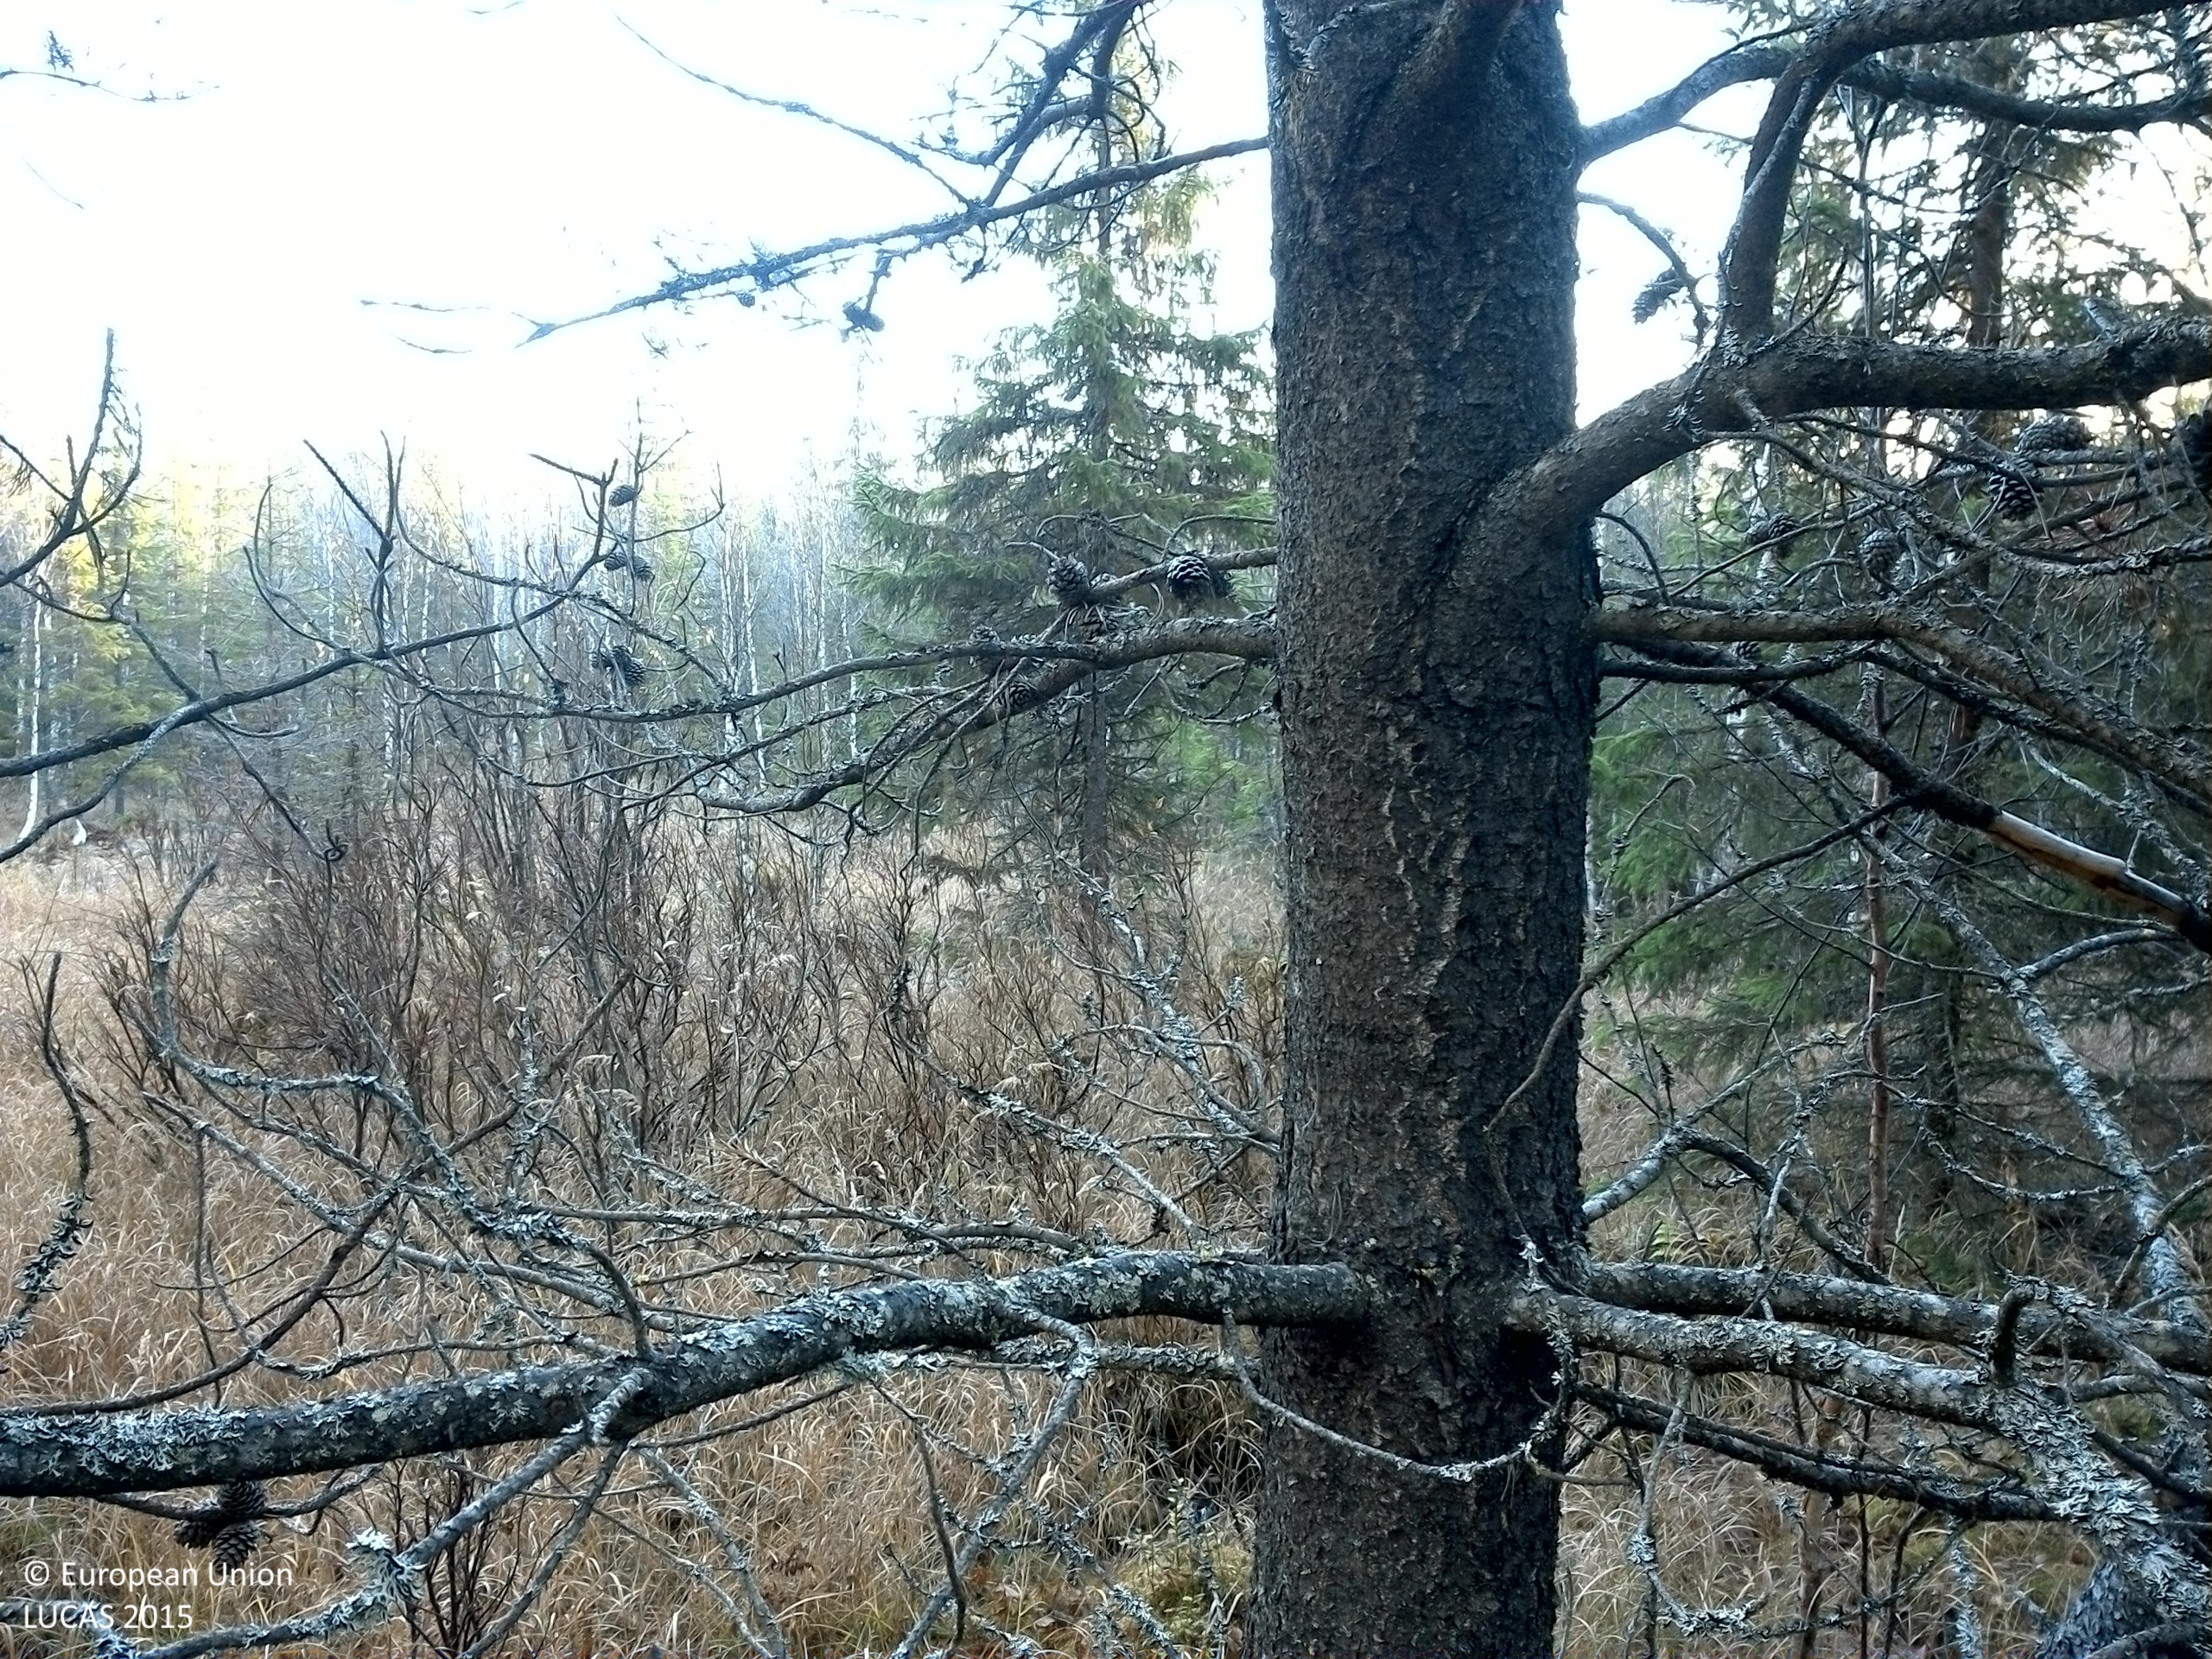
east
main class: Woodland
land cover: Pine dominated coniferous woodland
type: exotic forest
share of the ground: 50 - 75 %
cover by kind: coniferous forest trees 50 %, shrubs 20 %, lichens and mosses 15 %, herbaceous plants 10 %, consolidated bare surface 5 %
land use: Forestry
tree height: > 5 m
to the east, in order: Pine dominated coniferous woodland; Grassland with sparse tree/shrub cover; Spruce dominated mixed woodland; Pine dominated coniferous woodland; Shrubland without tree cover; Electric lines; Shrubland without tree cover; Pine dominated coniferous woodland; Spruce dominated mixed woodland
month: October
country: SE
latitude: 64.4456
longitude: 15.5593
